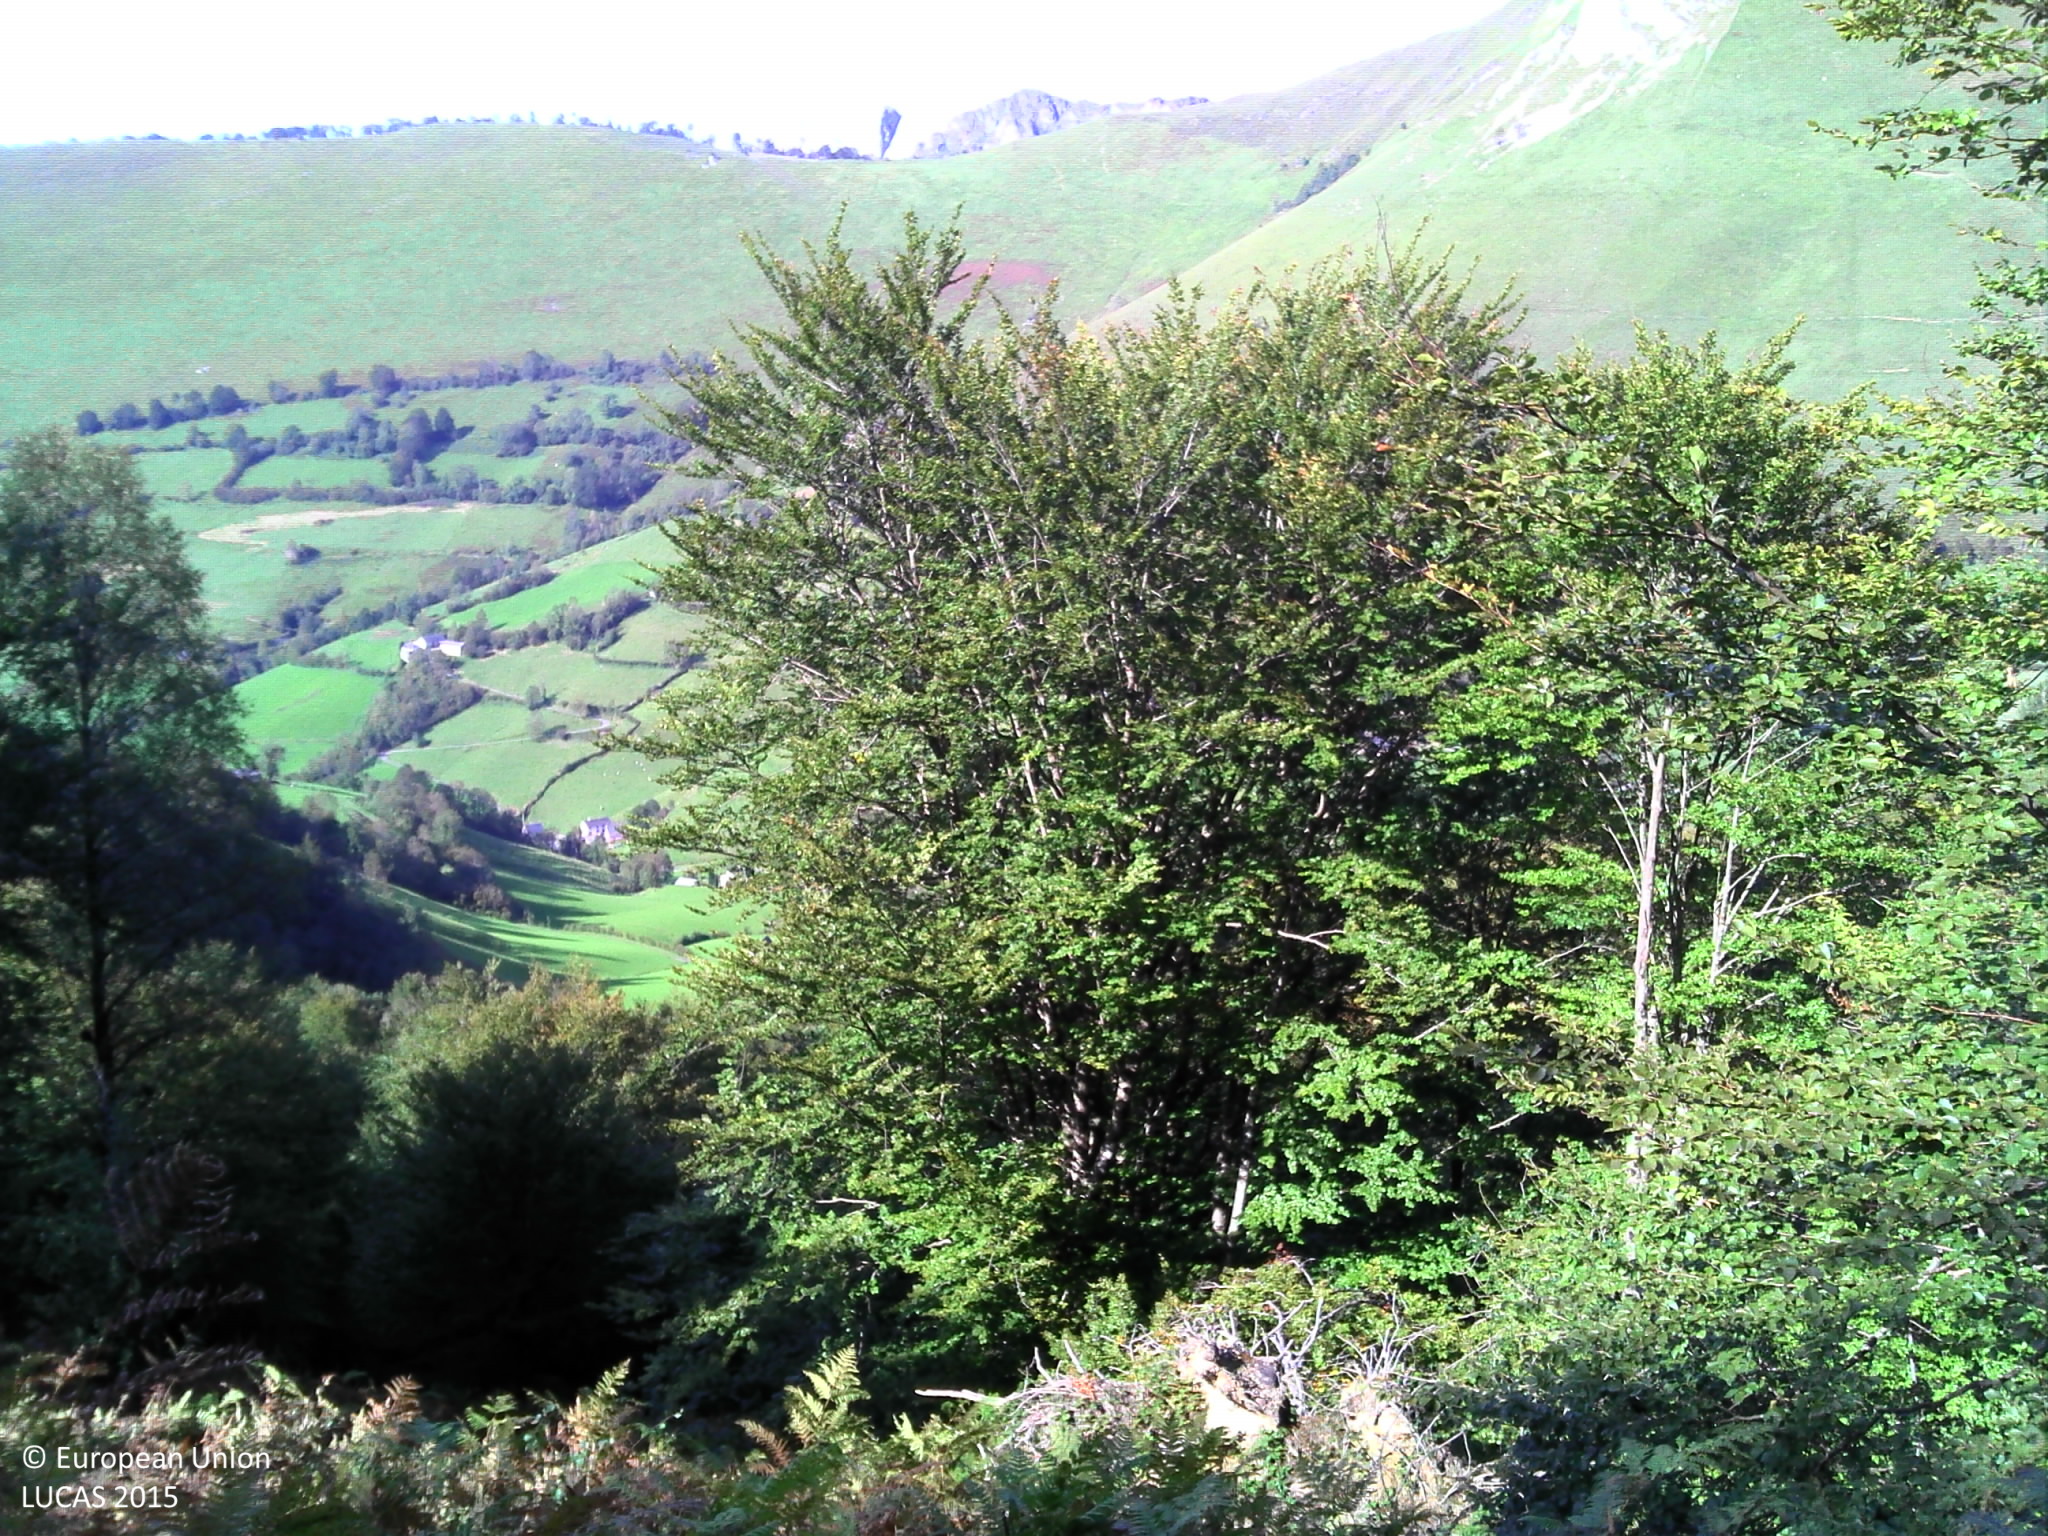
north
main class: Grassland
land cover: Spontaneously vegetated surfaces
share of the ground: > 75 %
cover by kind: herbaceous plants 95 %, shrubs 5 %
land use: Abandoned areas
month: September
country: FR
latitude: 43.0373
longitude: -0.6488
